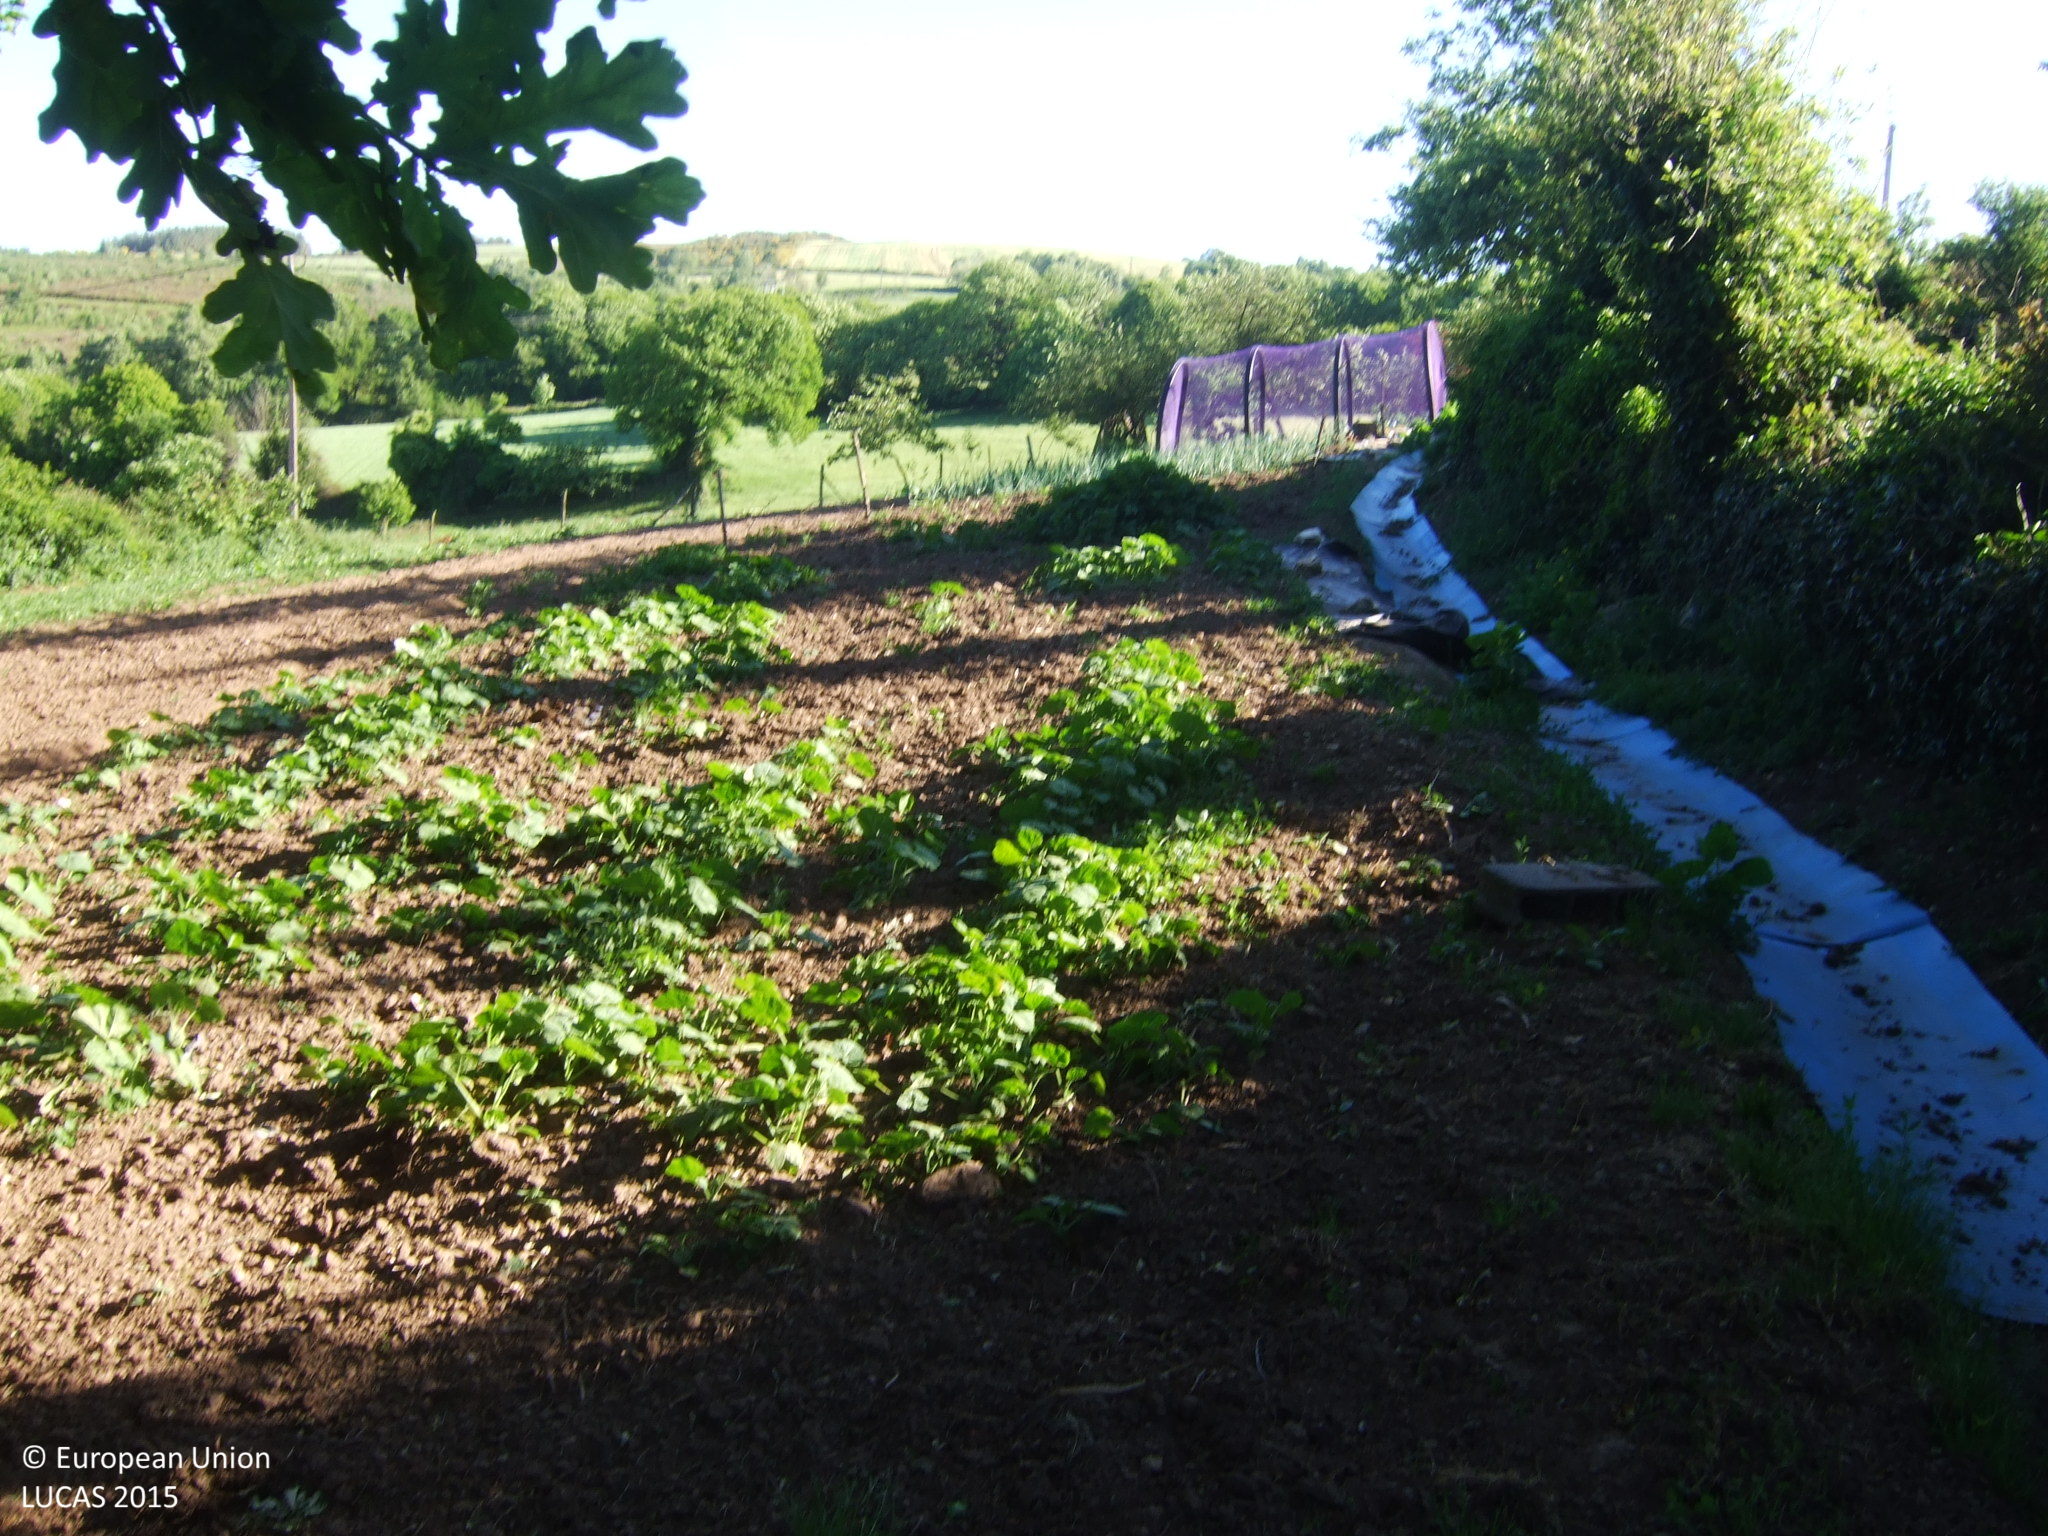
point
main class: Cropland
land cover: Other fresh vegetables
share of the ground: 25 - 50 %
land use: Kitchen garden
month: May
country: ES
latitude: 42.7122
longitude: -7.5455
